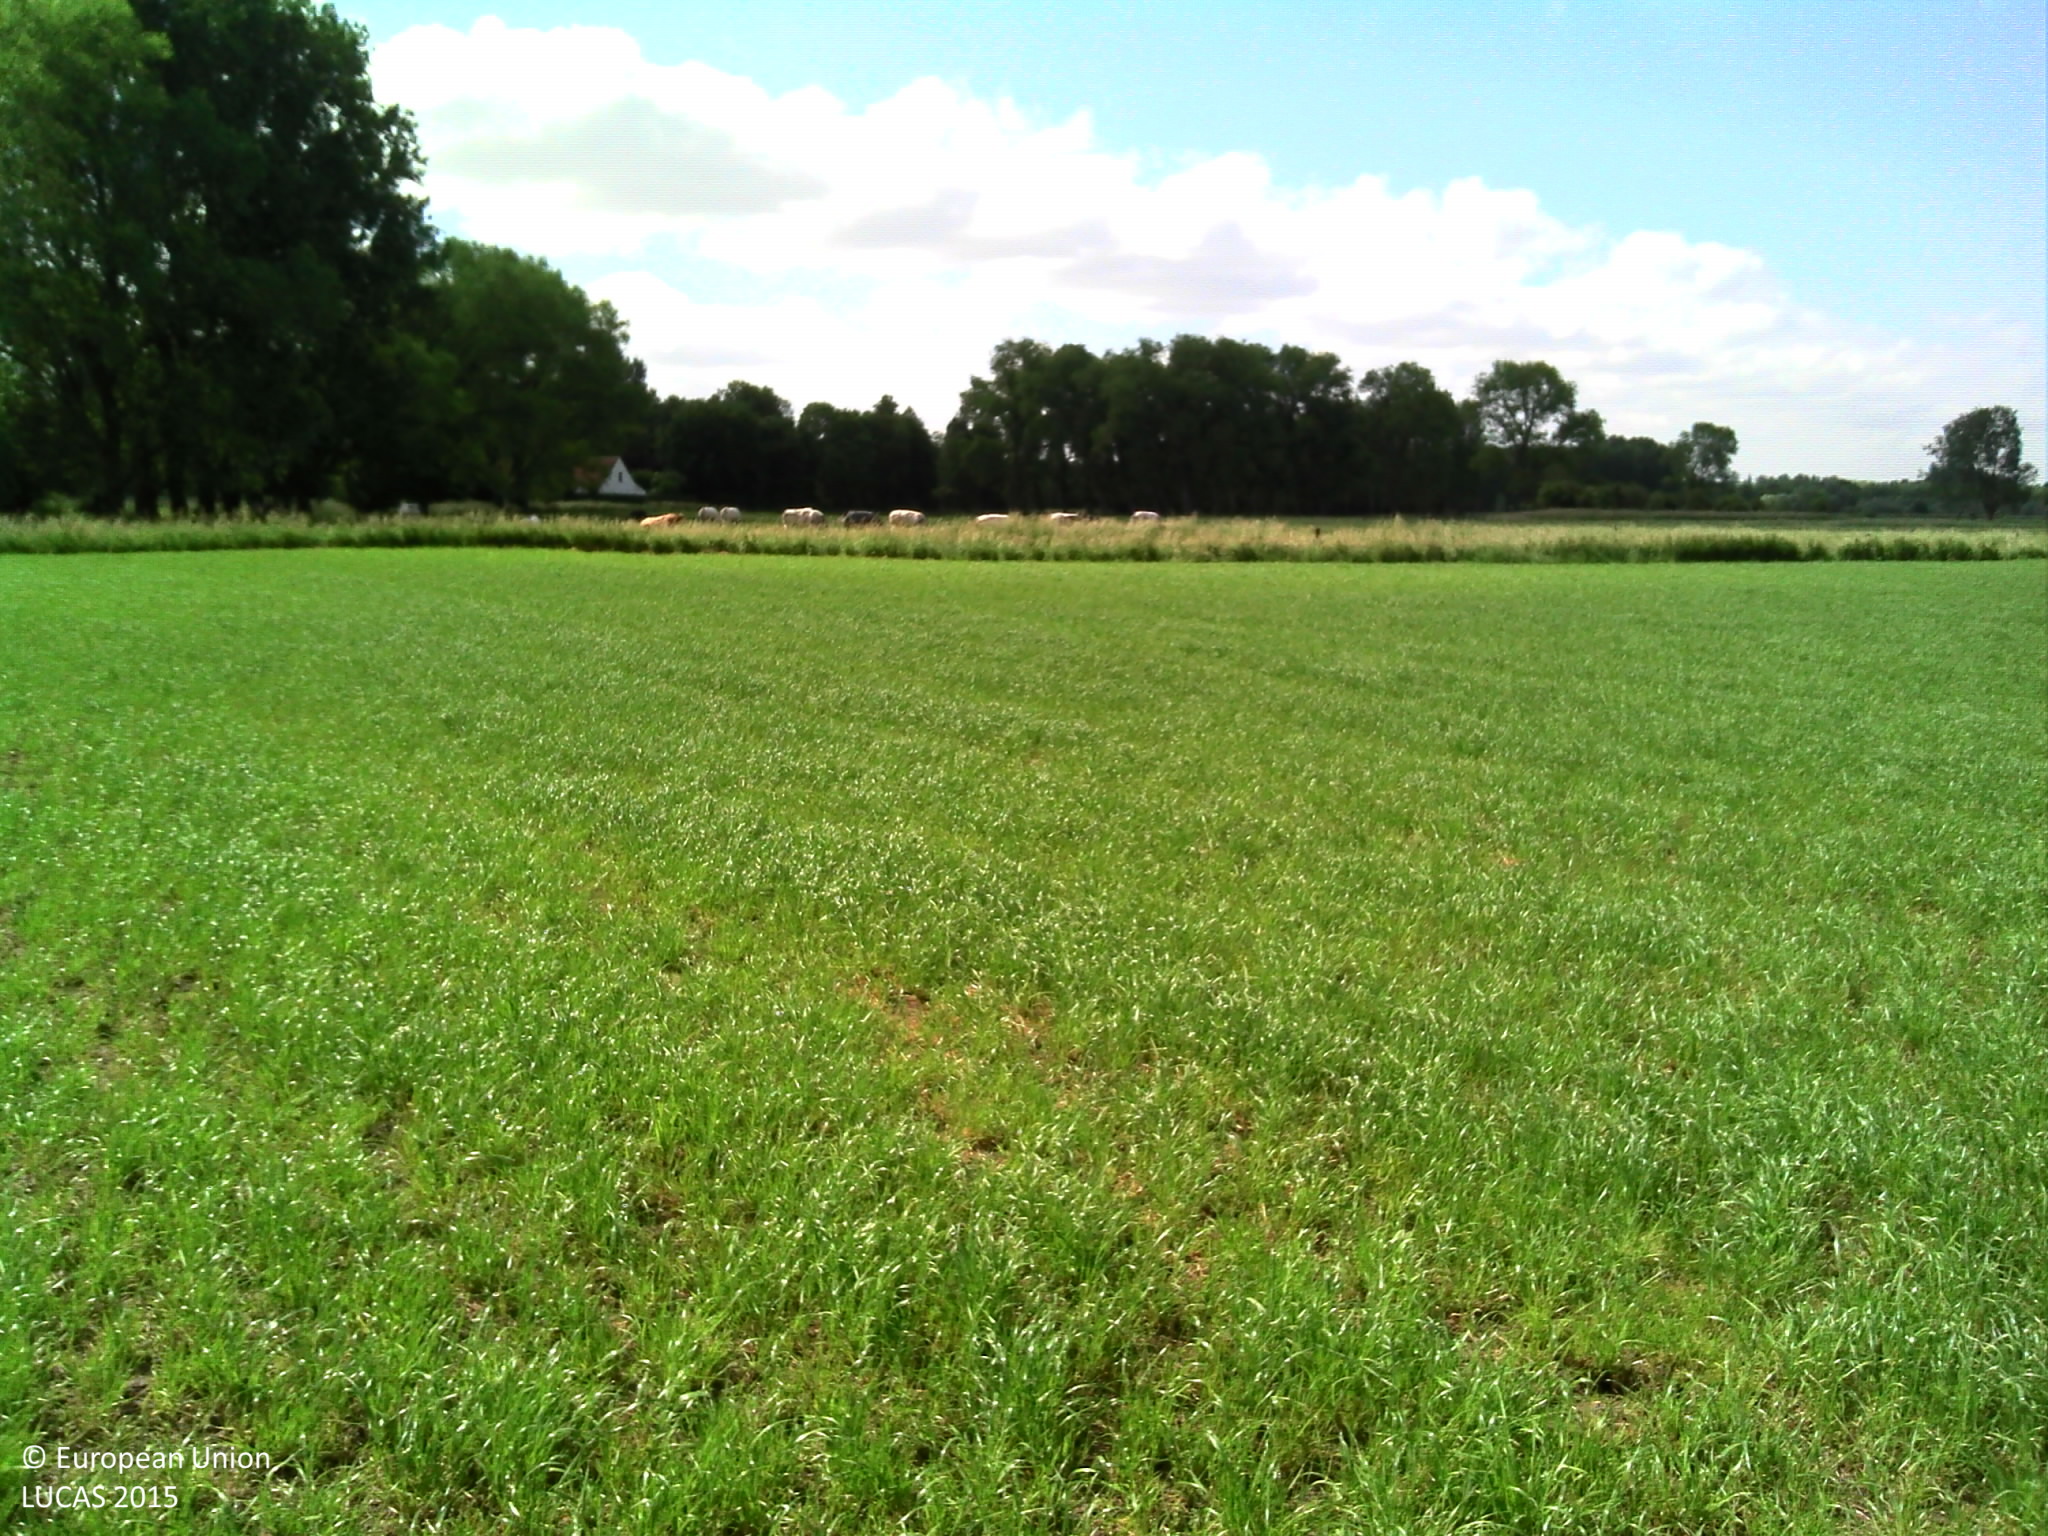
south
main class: Cropland
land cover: Temporary grasslands
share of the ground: > 75 %
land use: Agriculture (excluding fallow land and kitchen gardens)
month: June
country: BE
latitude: 50.9651
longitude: 3.6851
